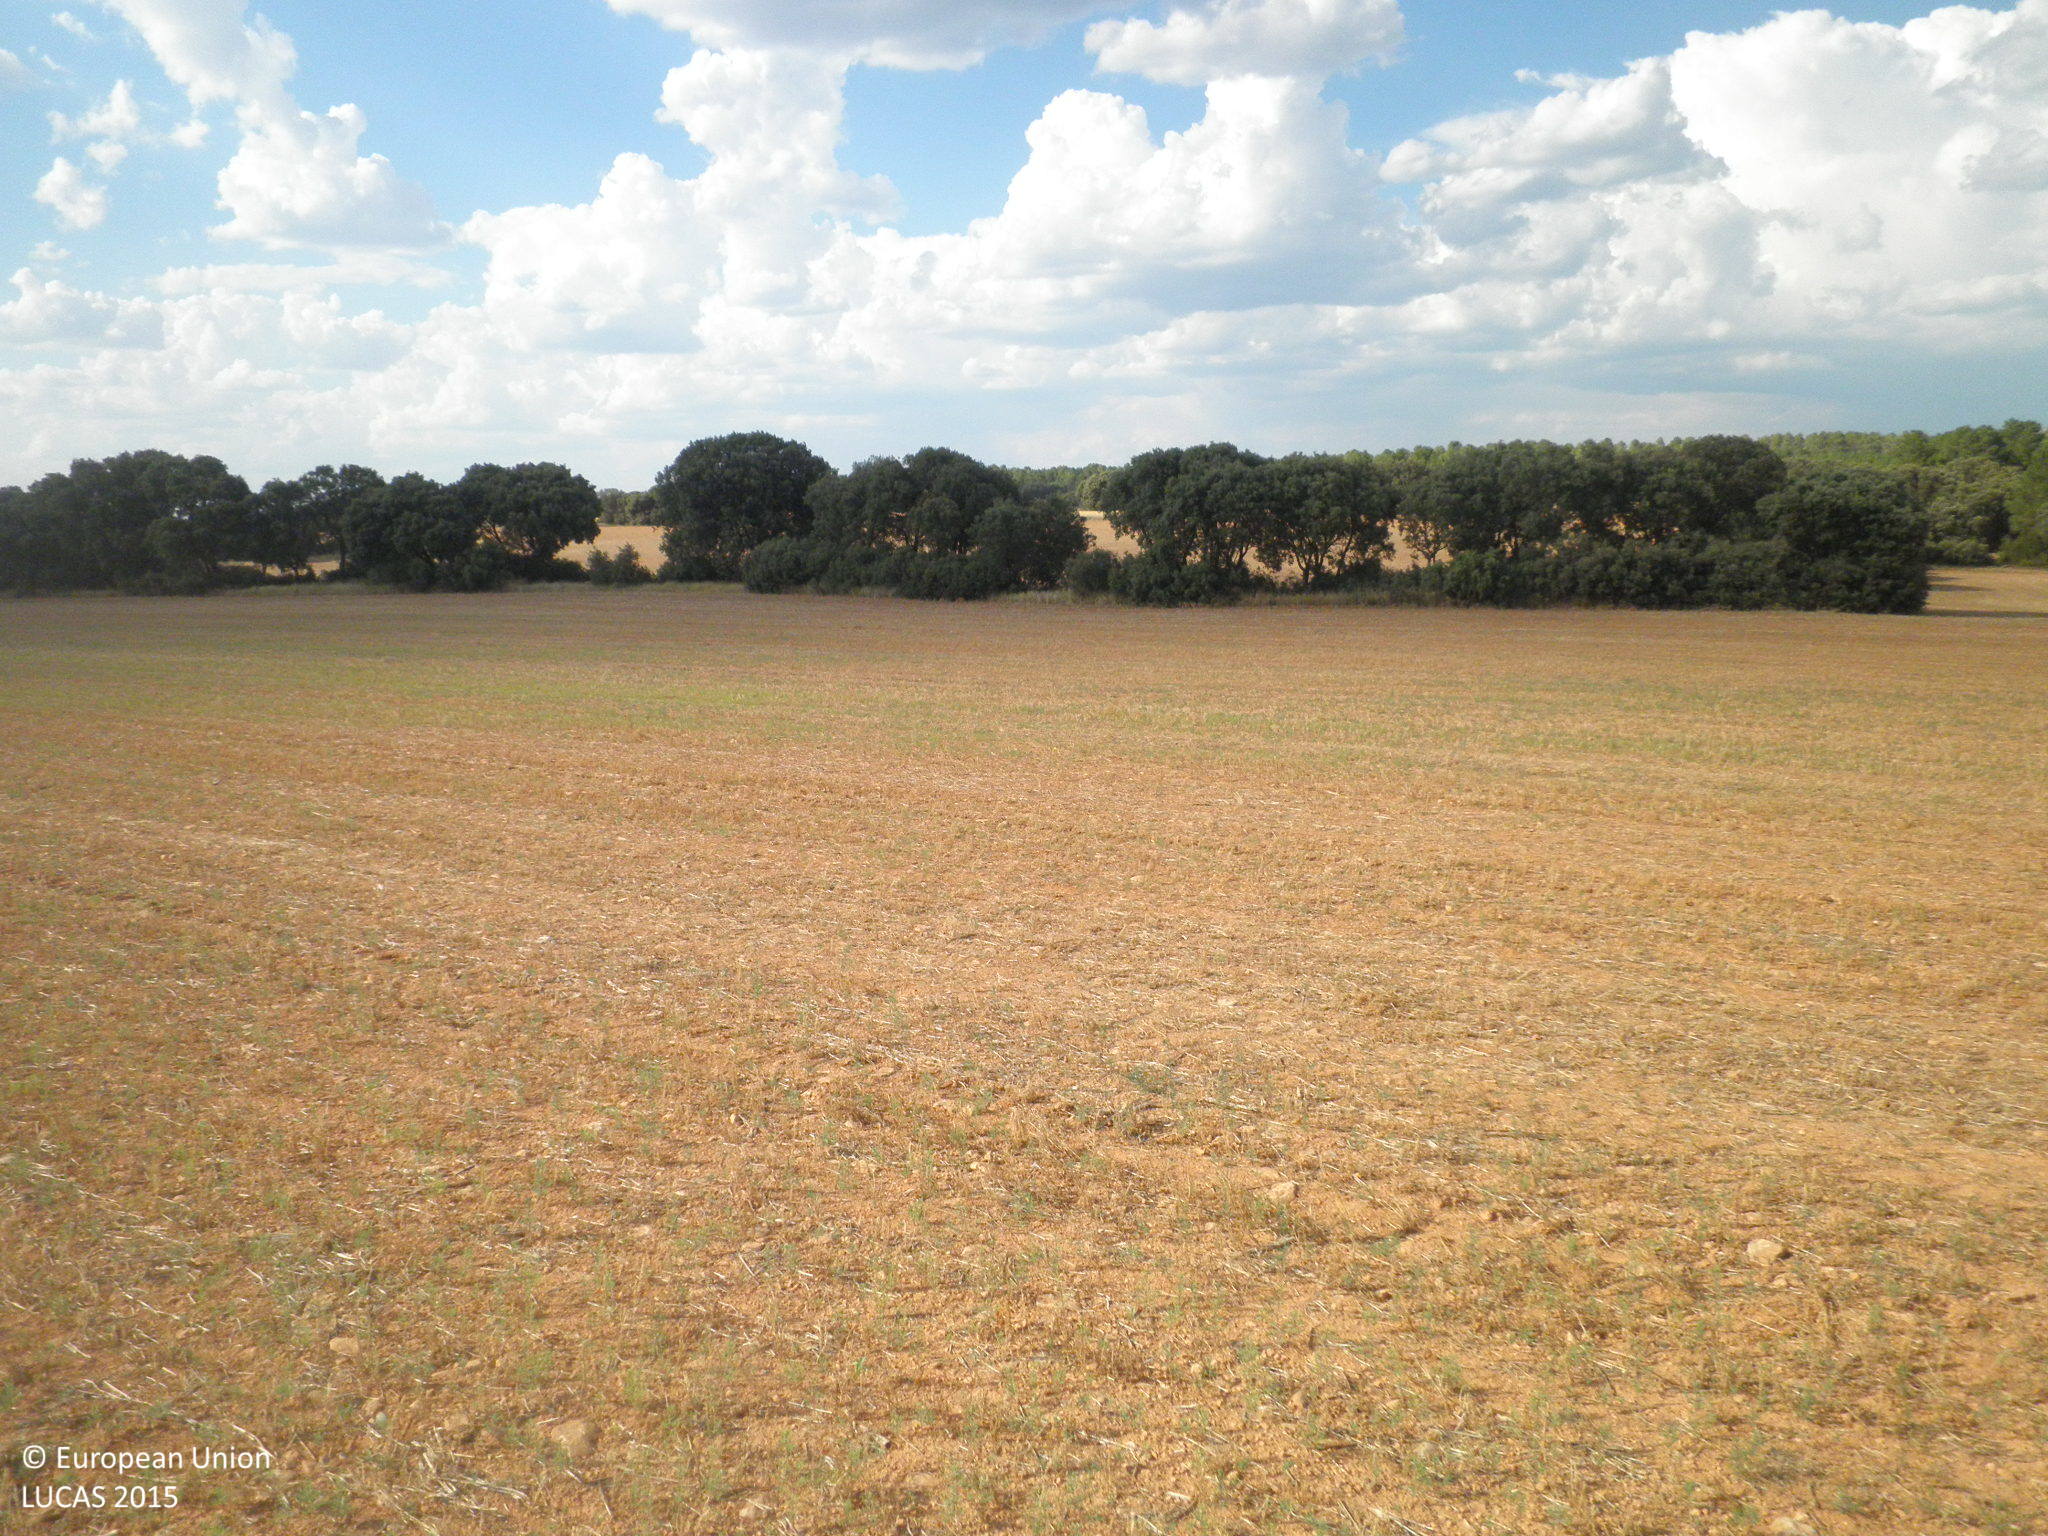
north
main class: Cropland
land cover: Dry pulses
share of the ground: < 10 %
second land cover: Spontaneously vegetated surfaces
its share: 10 - 25 %
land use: Agriculture (excluding fallow land and kitchen gardens)
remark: Harvested field
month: July
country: ES
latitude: 39.6028
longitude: -1.6876
